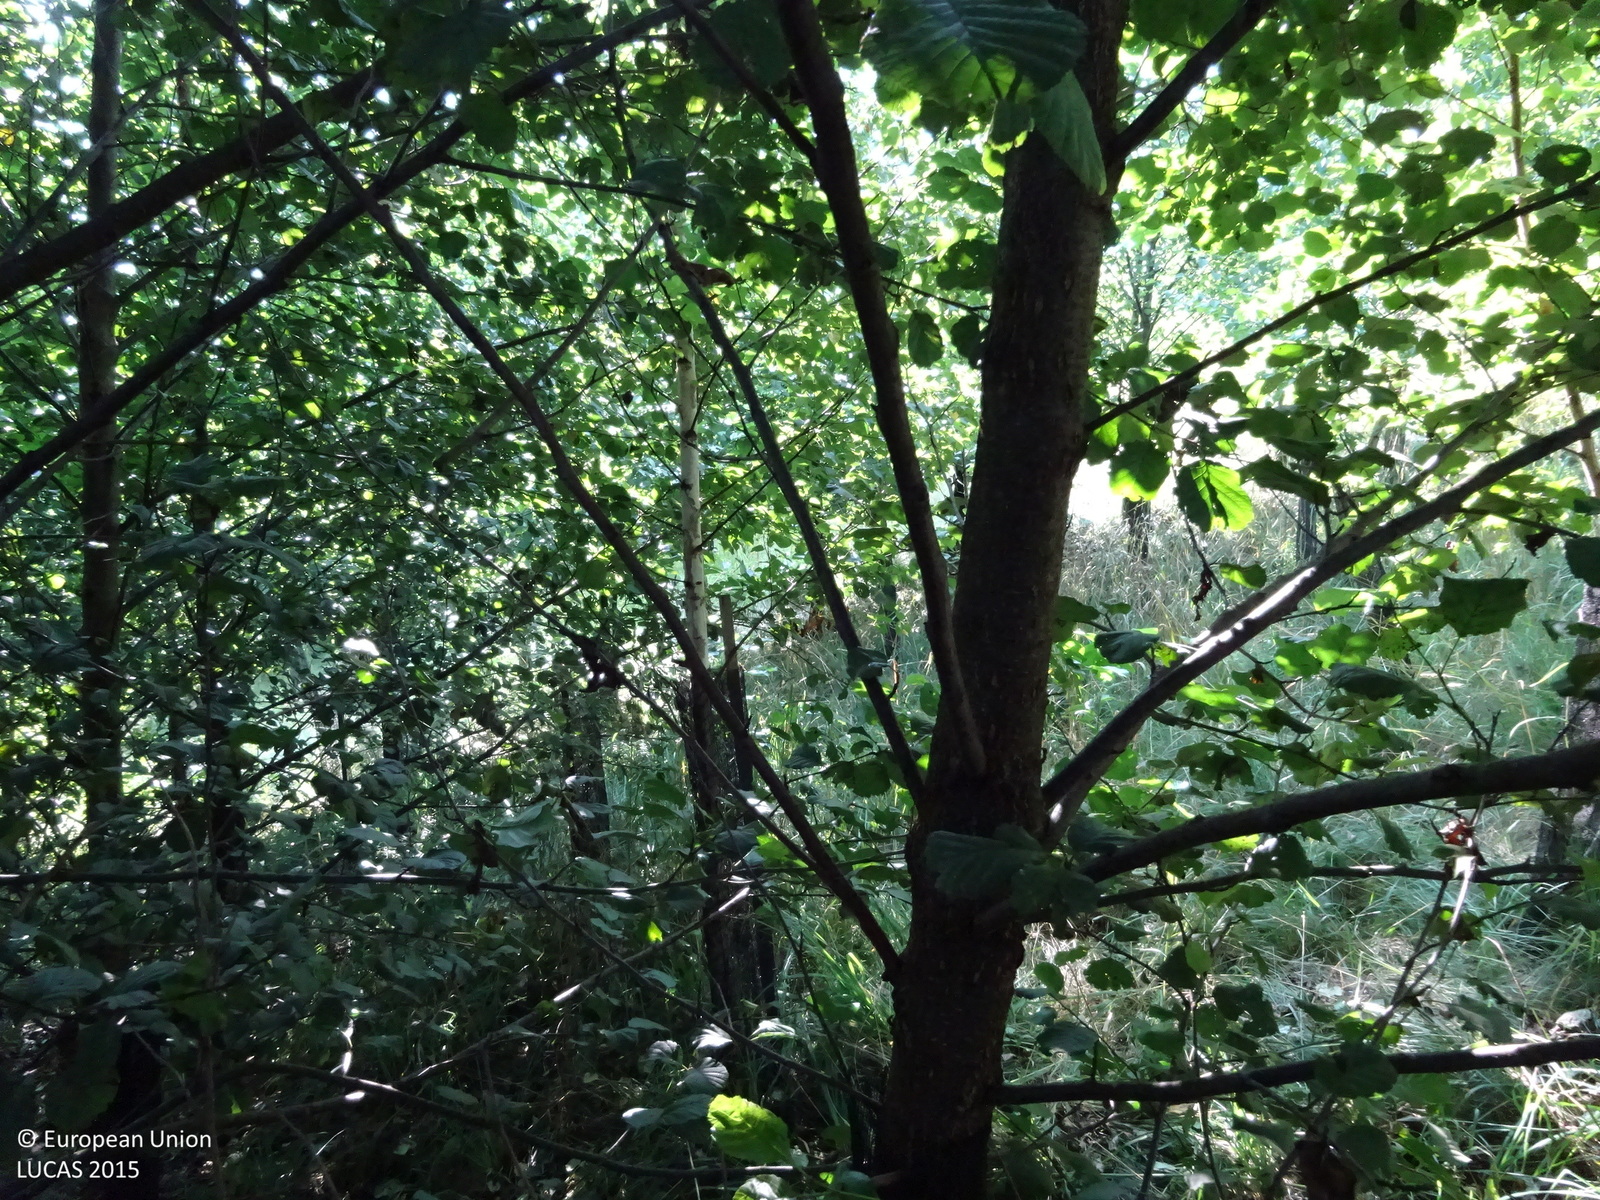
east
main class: Woodland
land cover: Broadleaved woodland
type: hemiboreal forest and nemoral coniferous forest and mixed broadleaved-coniferous forest
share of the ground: > 75 %
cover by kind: broadleaved forest trees 100 %
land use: Forestry
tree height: > 5 m
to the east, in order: Broadleaved woodland; Shrubland without tree cover; Broadleaved woodland; Shrubland without tree cover; Grassland without tree/shrub cover; Artificial constructions in urban areas
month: July
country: AT
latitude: 46.8790
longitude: 15.4712
